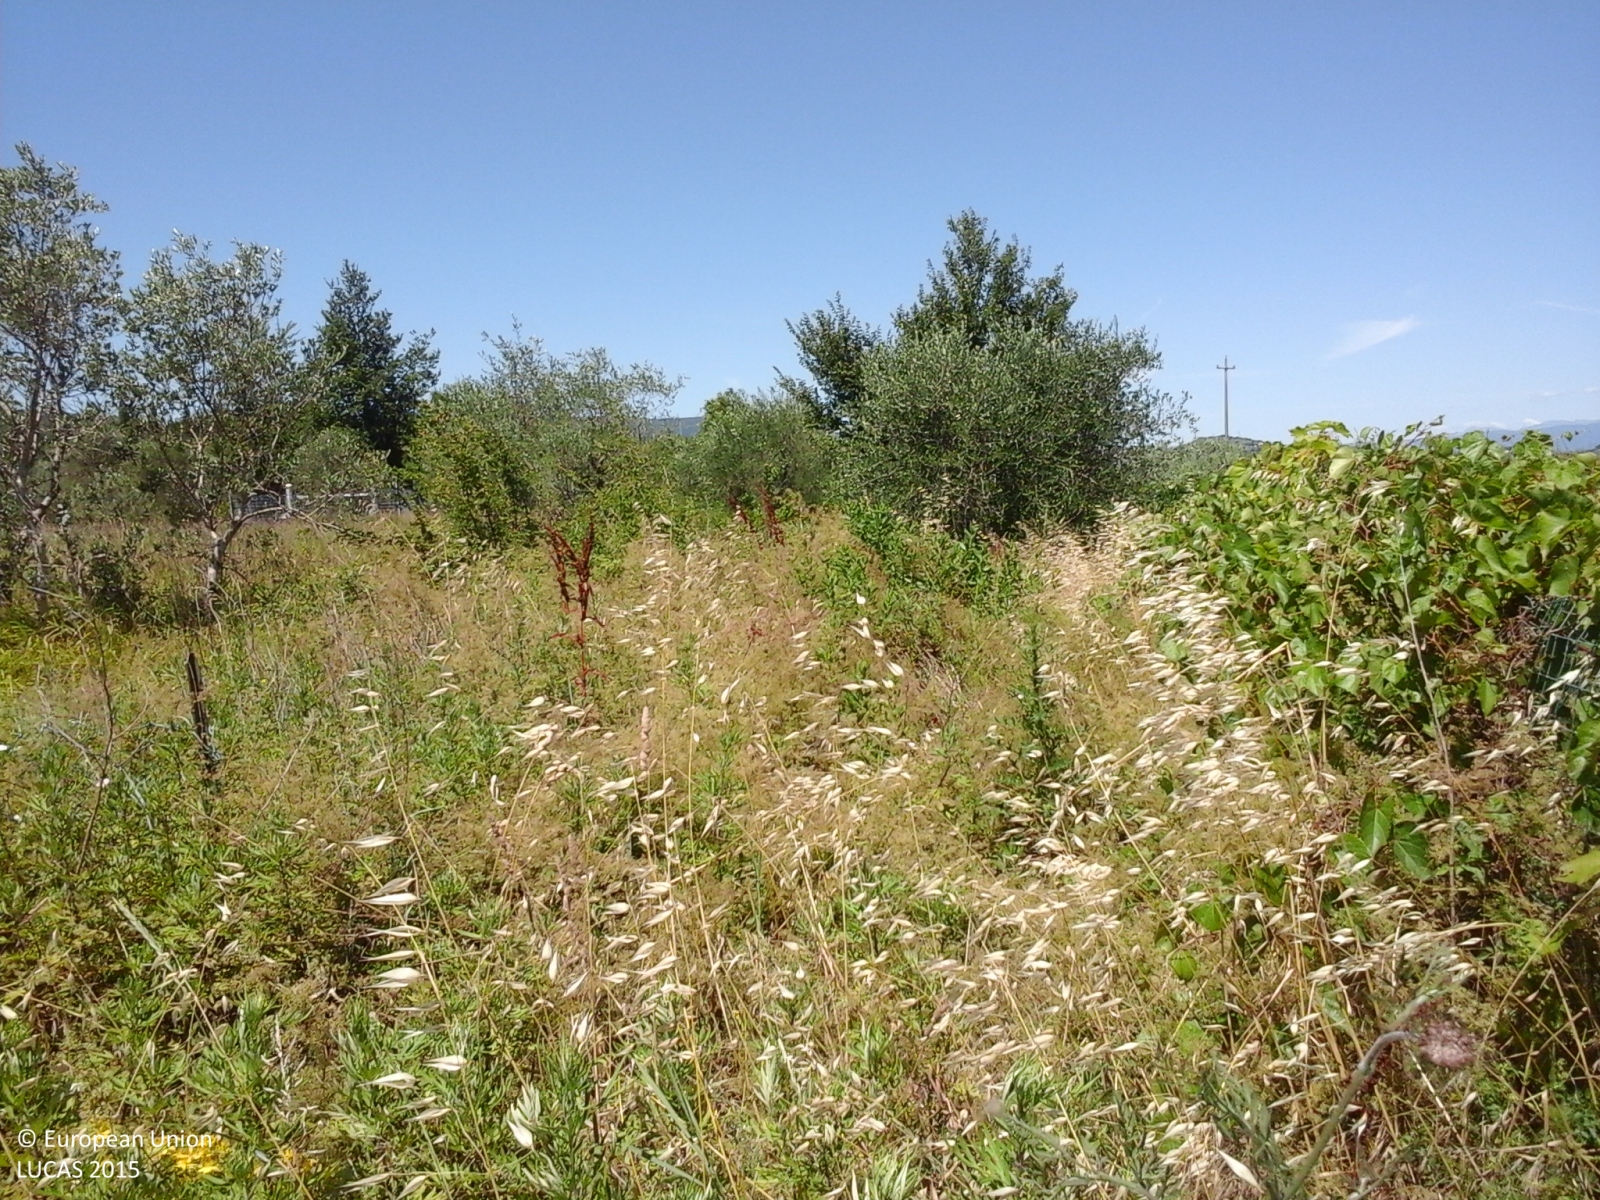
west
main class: Grassland
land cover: Grassland without tree/shrub cover
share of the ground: > 75 %
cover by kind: herbaceous plants 100 %
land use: Agriculture (excluding fallow land and kitchen gardens)
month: June
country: IT
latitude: 43.7857
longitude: 11.0783
